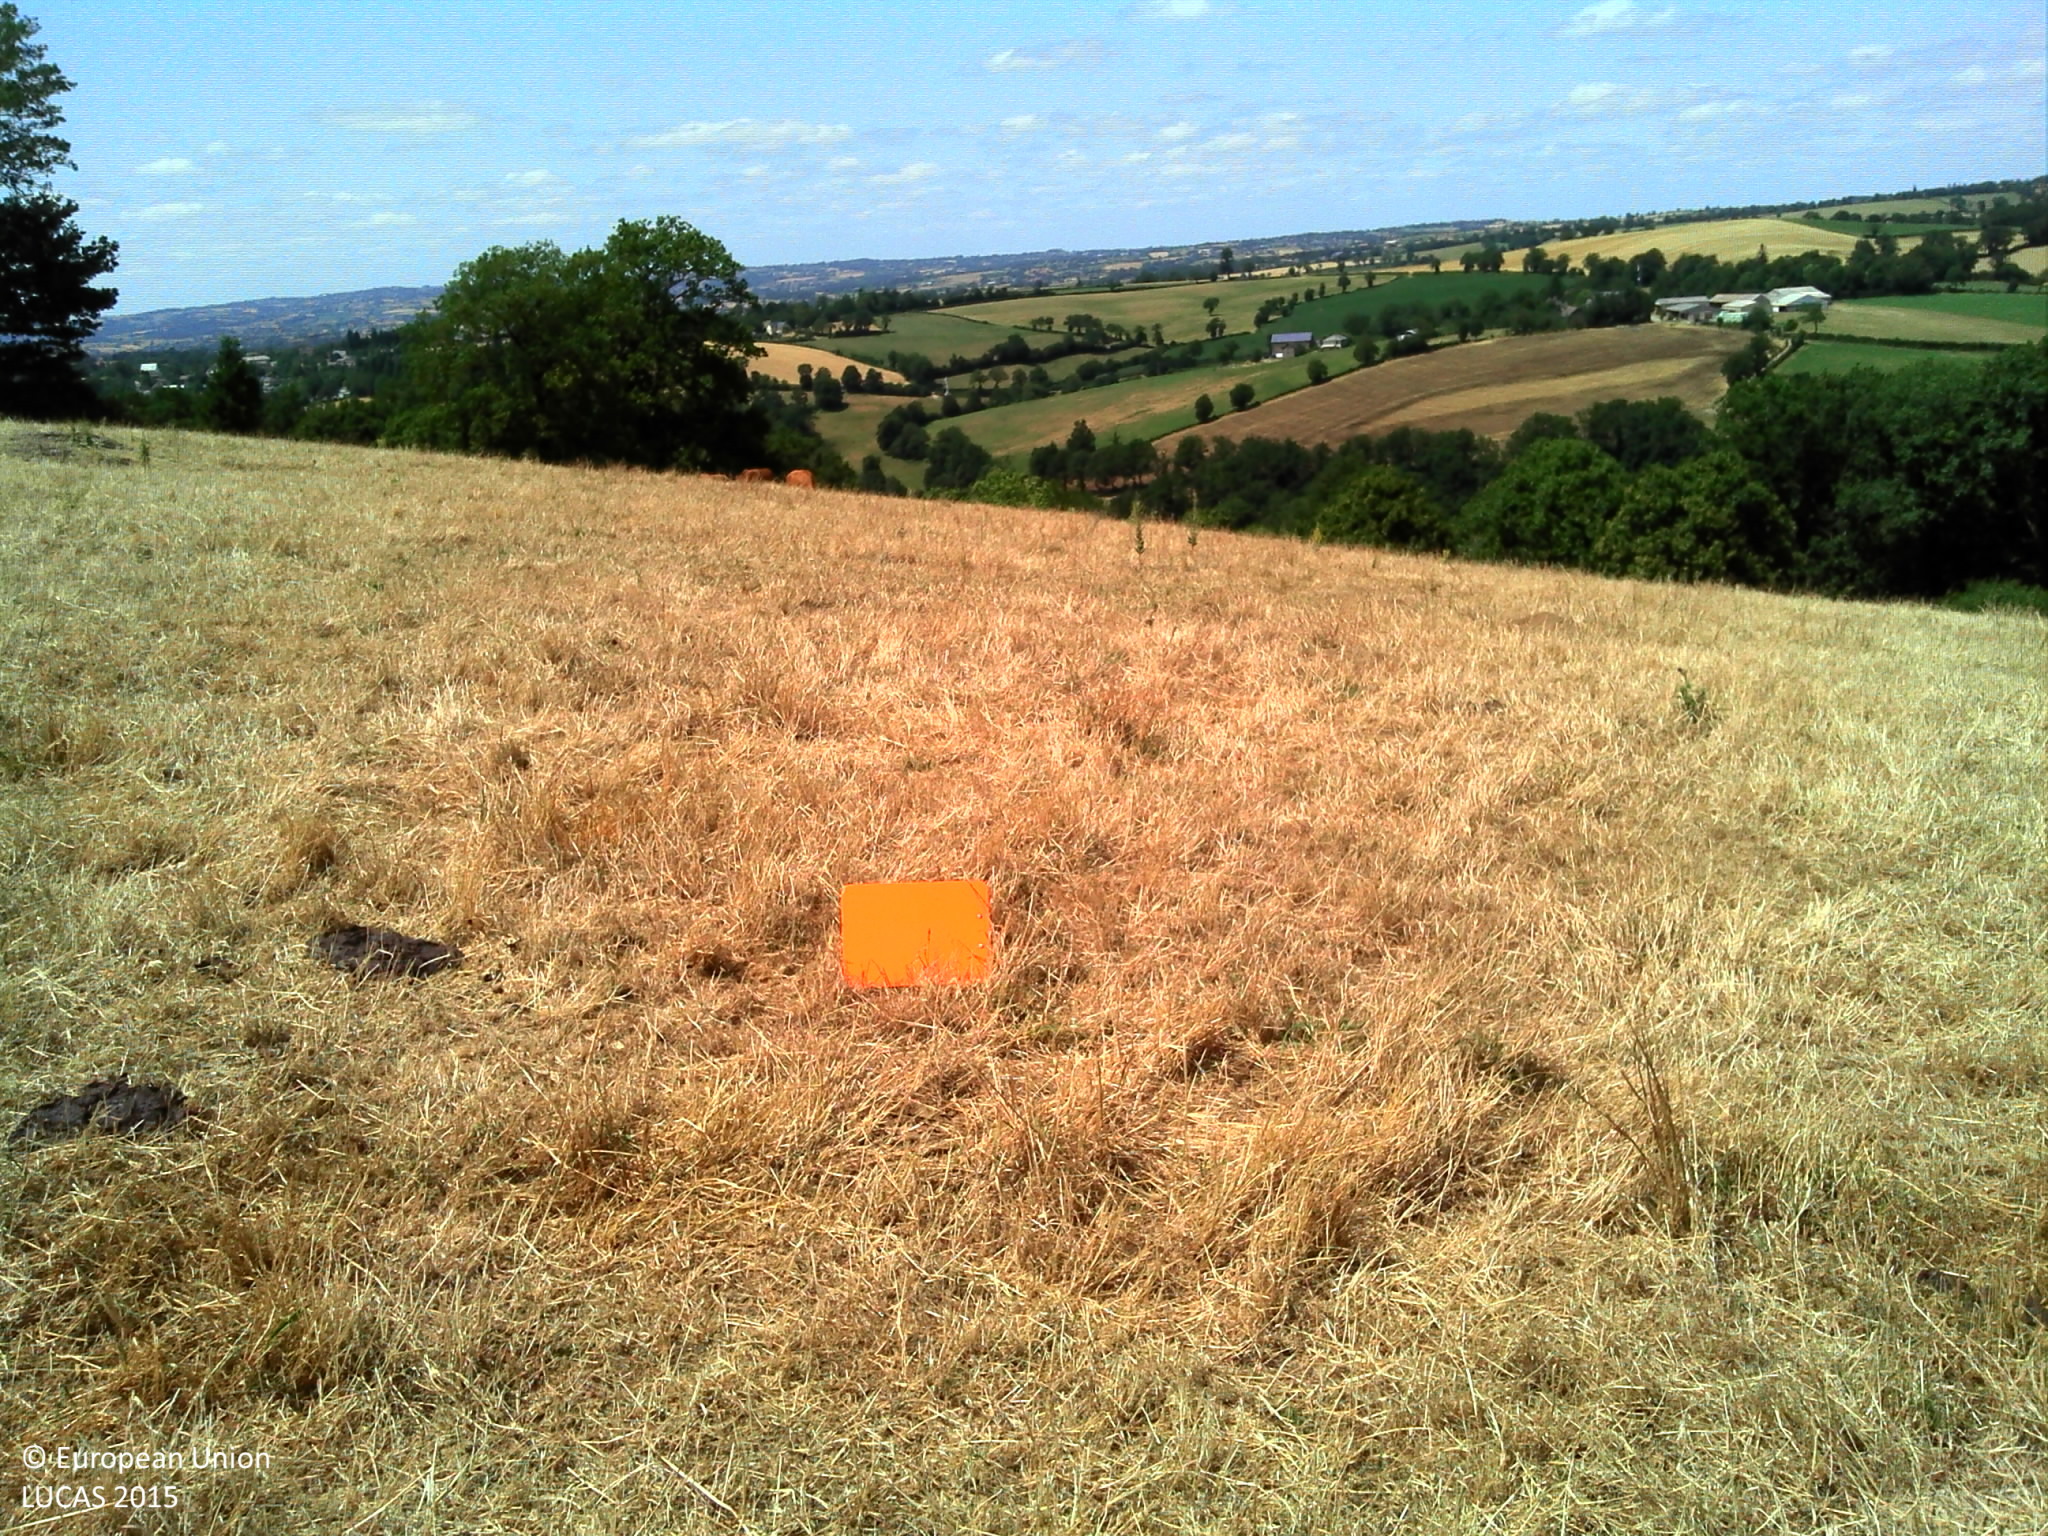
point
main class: Grassland
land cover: Grassland without tree/shrub cover
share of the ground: > 75 %
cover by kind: herbaceous plants 100 %
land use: Agriculture (excluding fallow land and kitchen gardens)
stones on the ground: 10 - 25 %
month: July
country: FR
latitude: 44.1757
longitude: 2.5870
